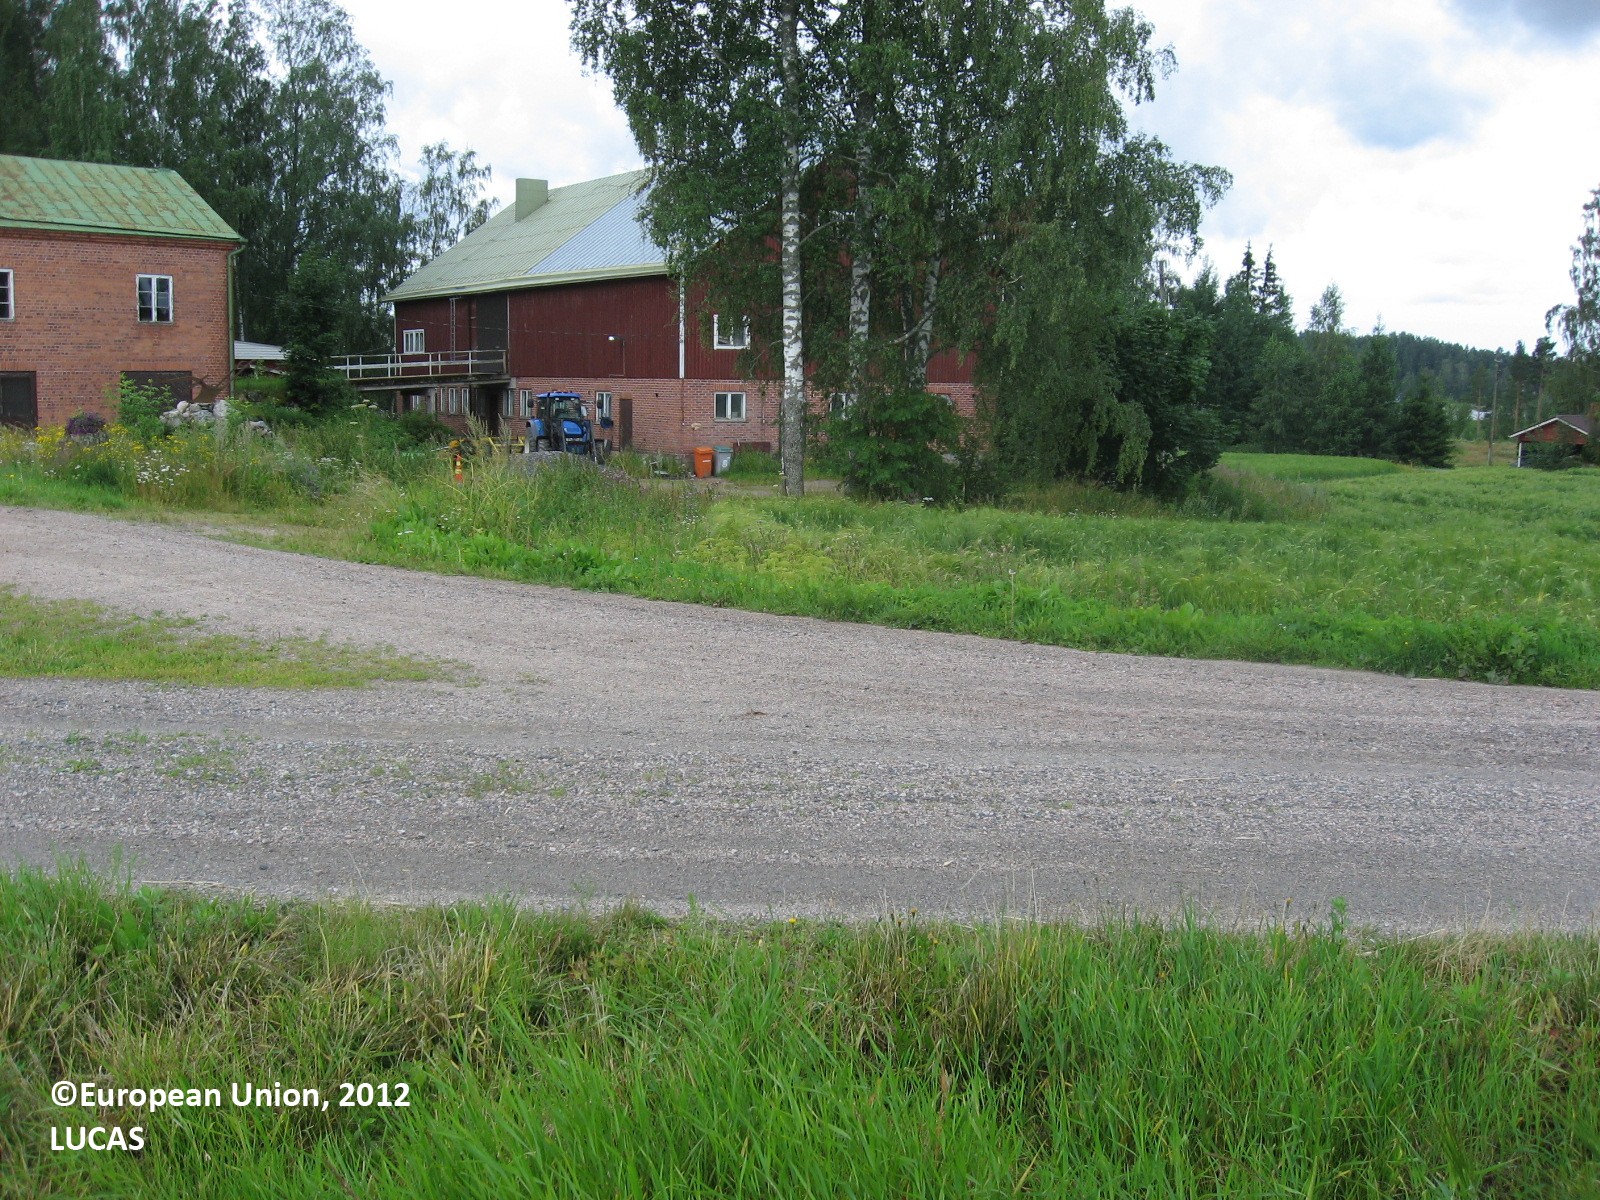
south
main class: Cropland
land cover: Barley
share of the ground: > 75 %
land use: Agriculture (excluding fallow land and kitchen gardens)
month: July
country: FI
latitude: 61.0682
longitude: 25.6384
